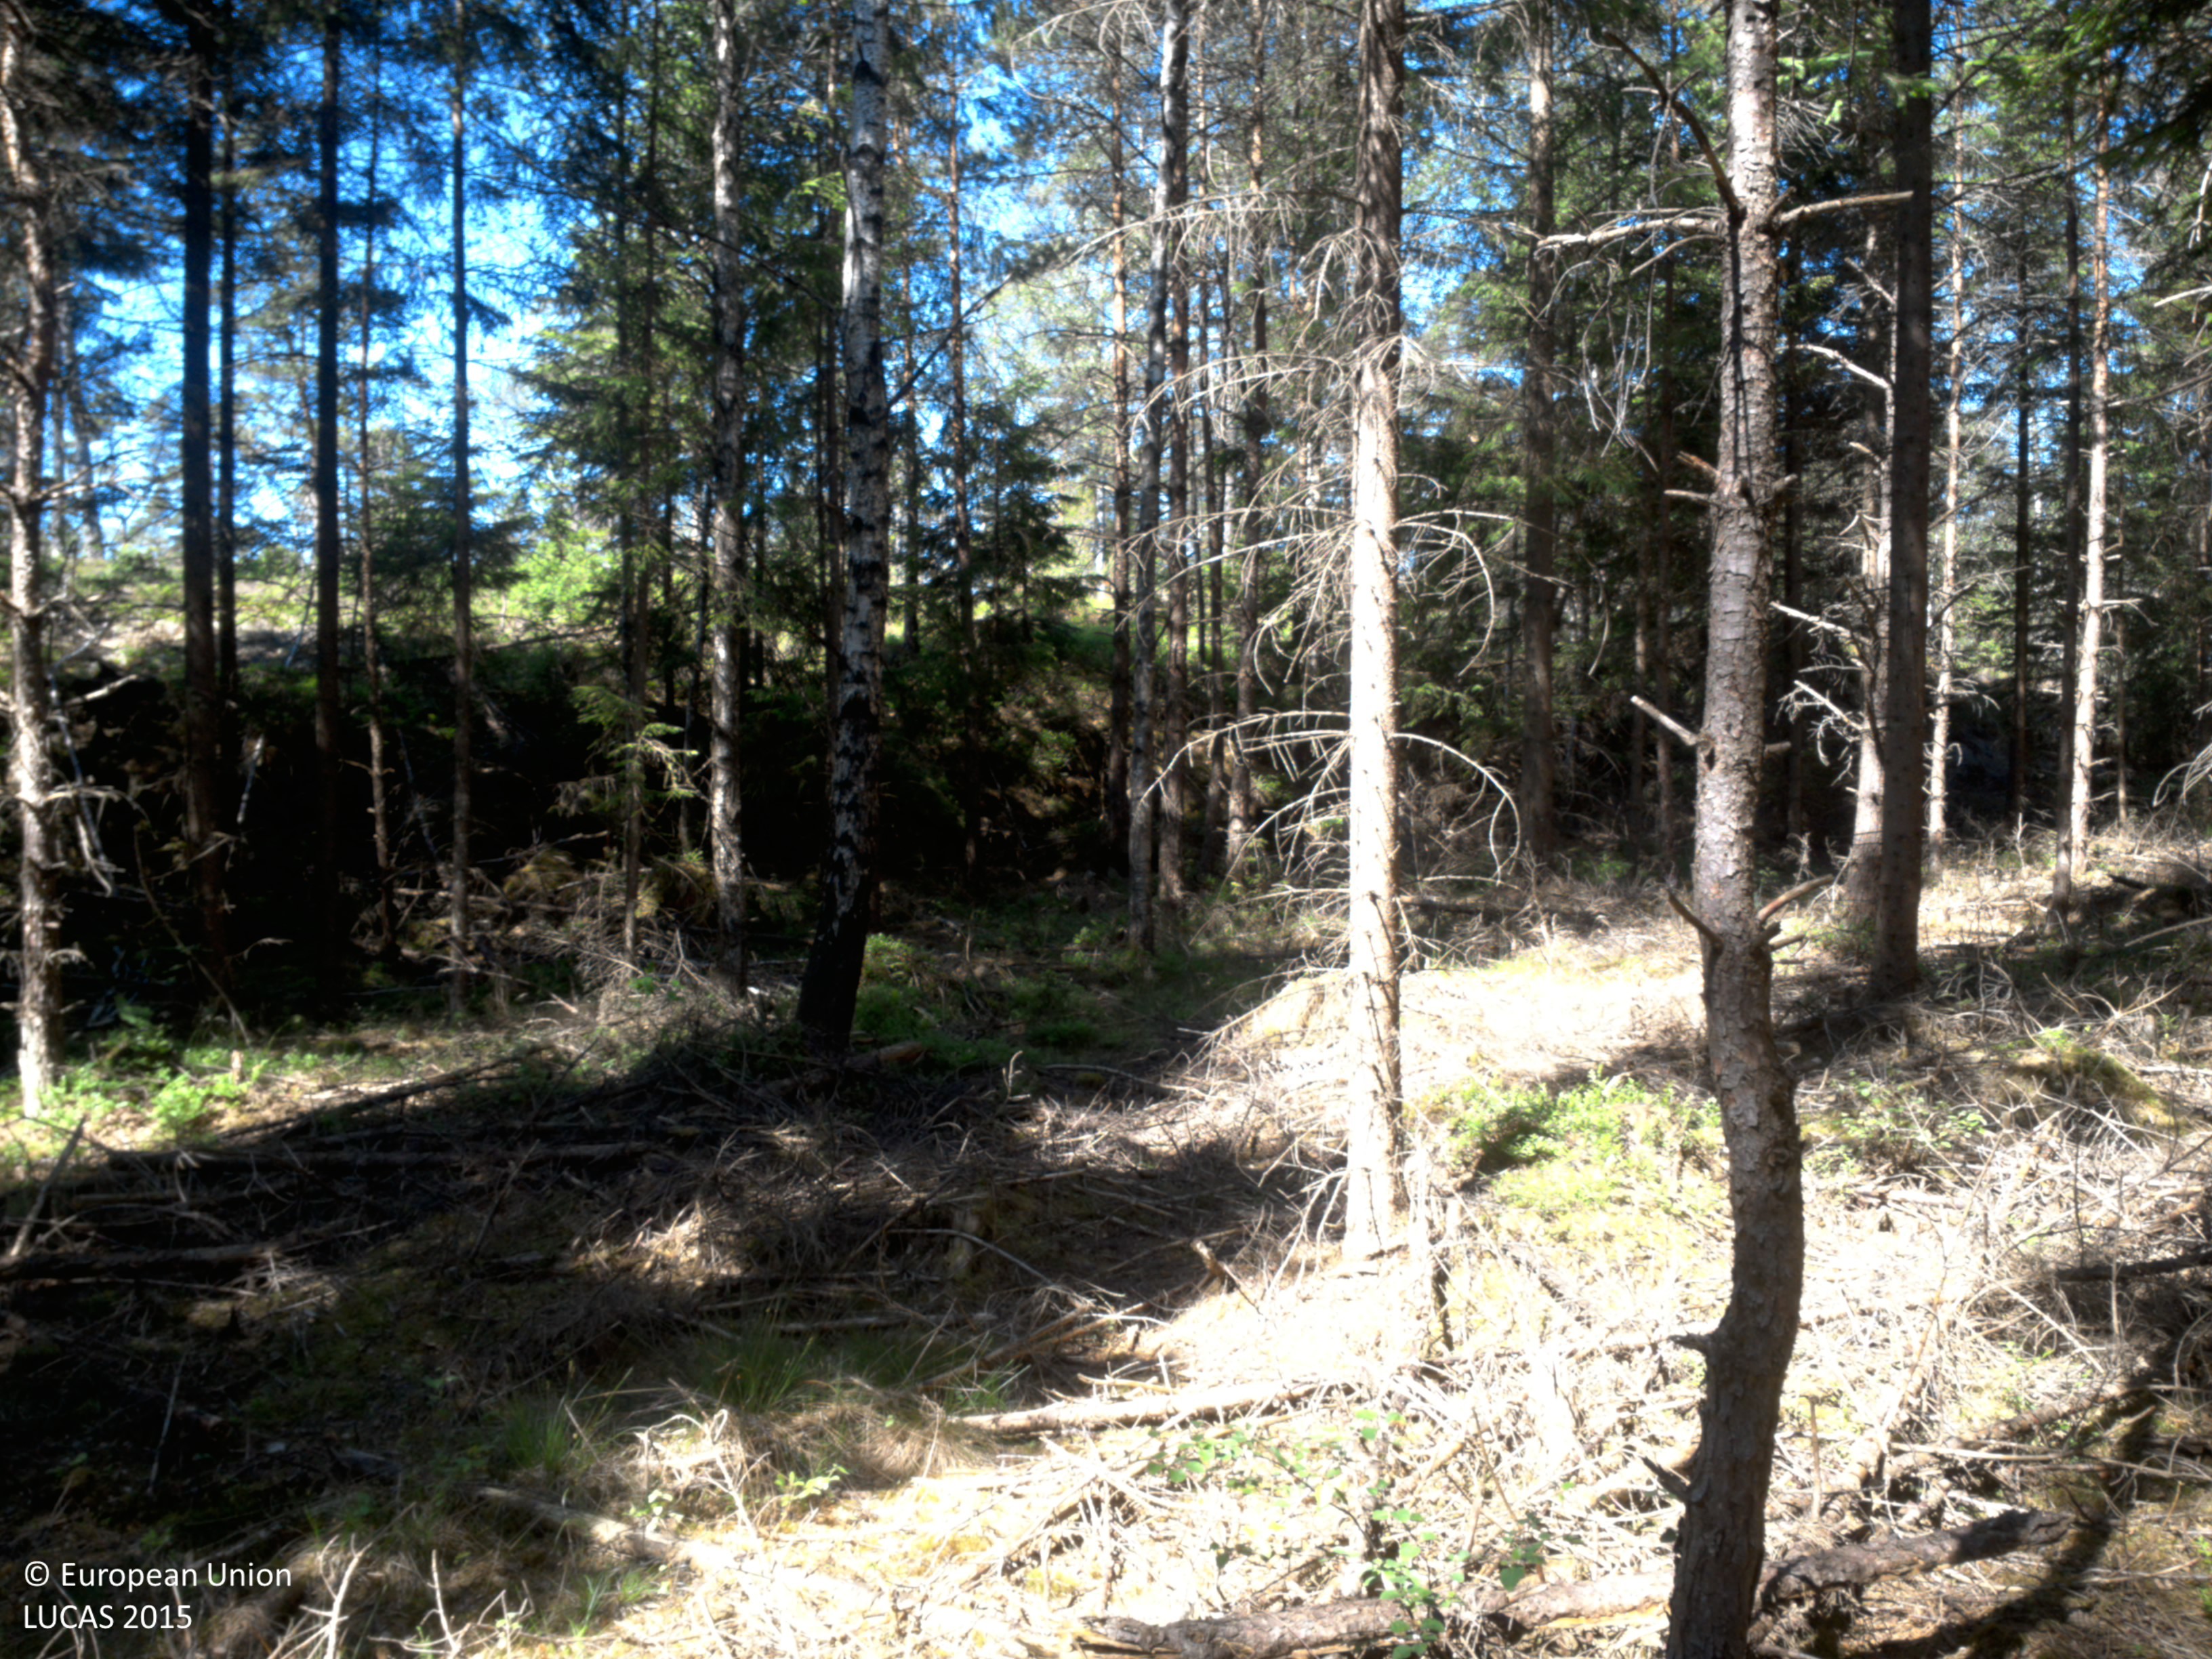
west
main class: Woodland
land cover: Other coniferous woodland
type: boreal forest
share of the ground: 50 - 75 %
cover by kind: coniferous forest trees 50 %, herbaceous plants 30 %, lichens and mosses 10 %, broadleaved forest trees 5 %, shrubs 5 %
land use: Forestry
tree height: > 5 m
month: July
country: SE
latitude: 58.5124
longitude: 11.8671
